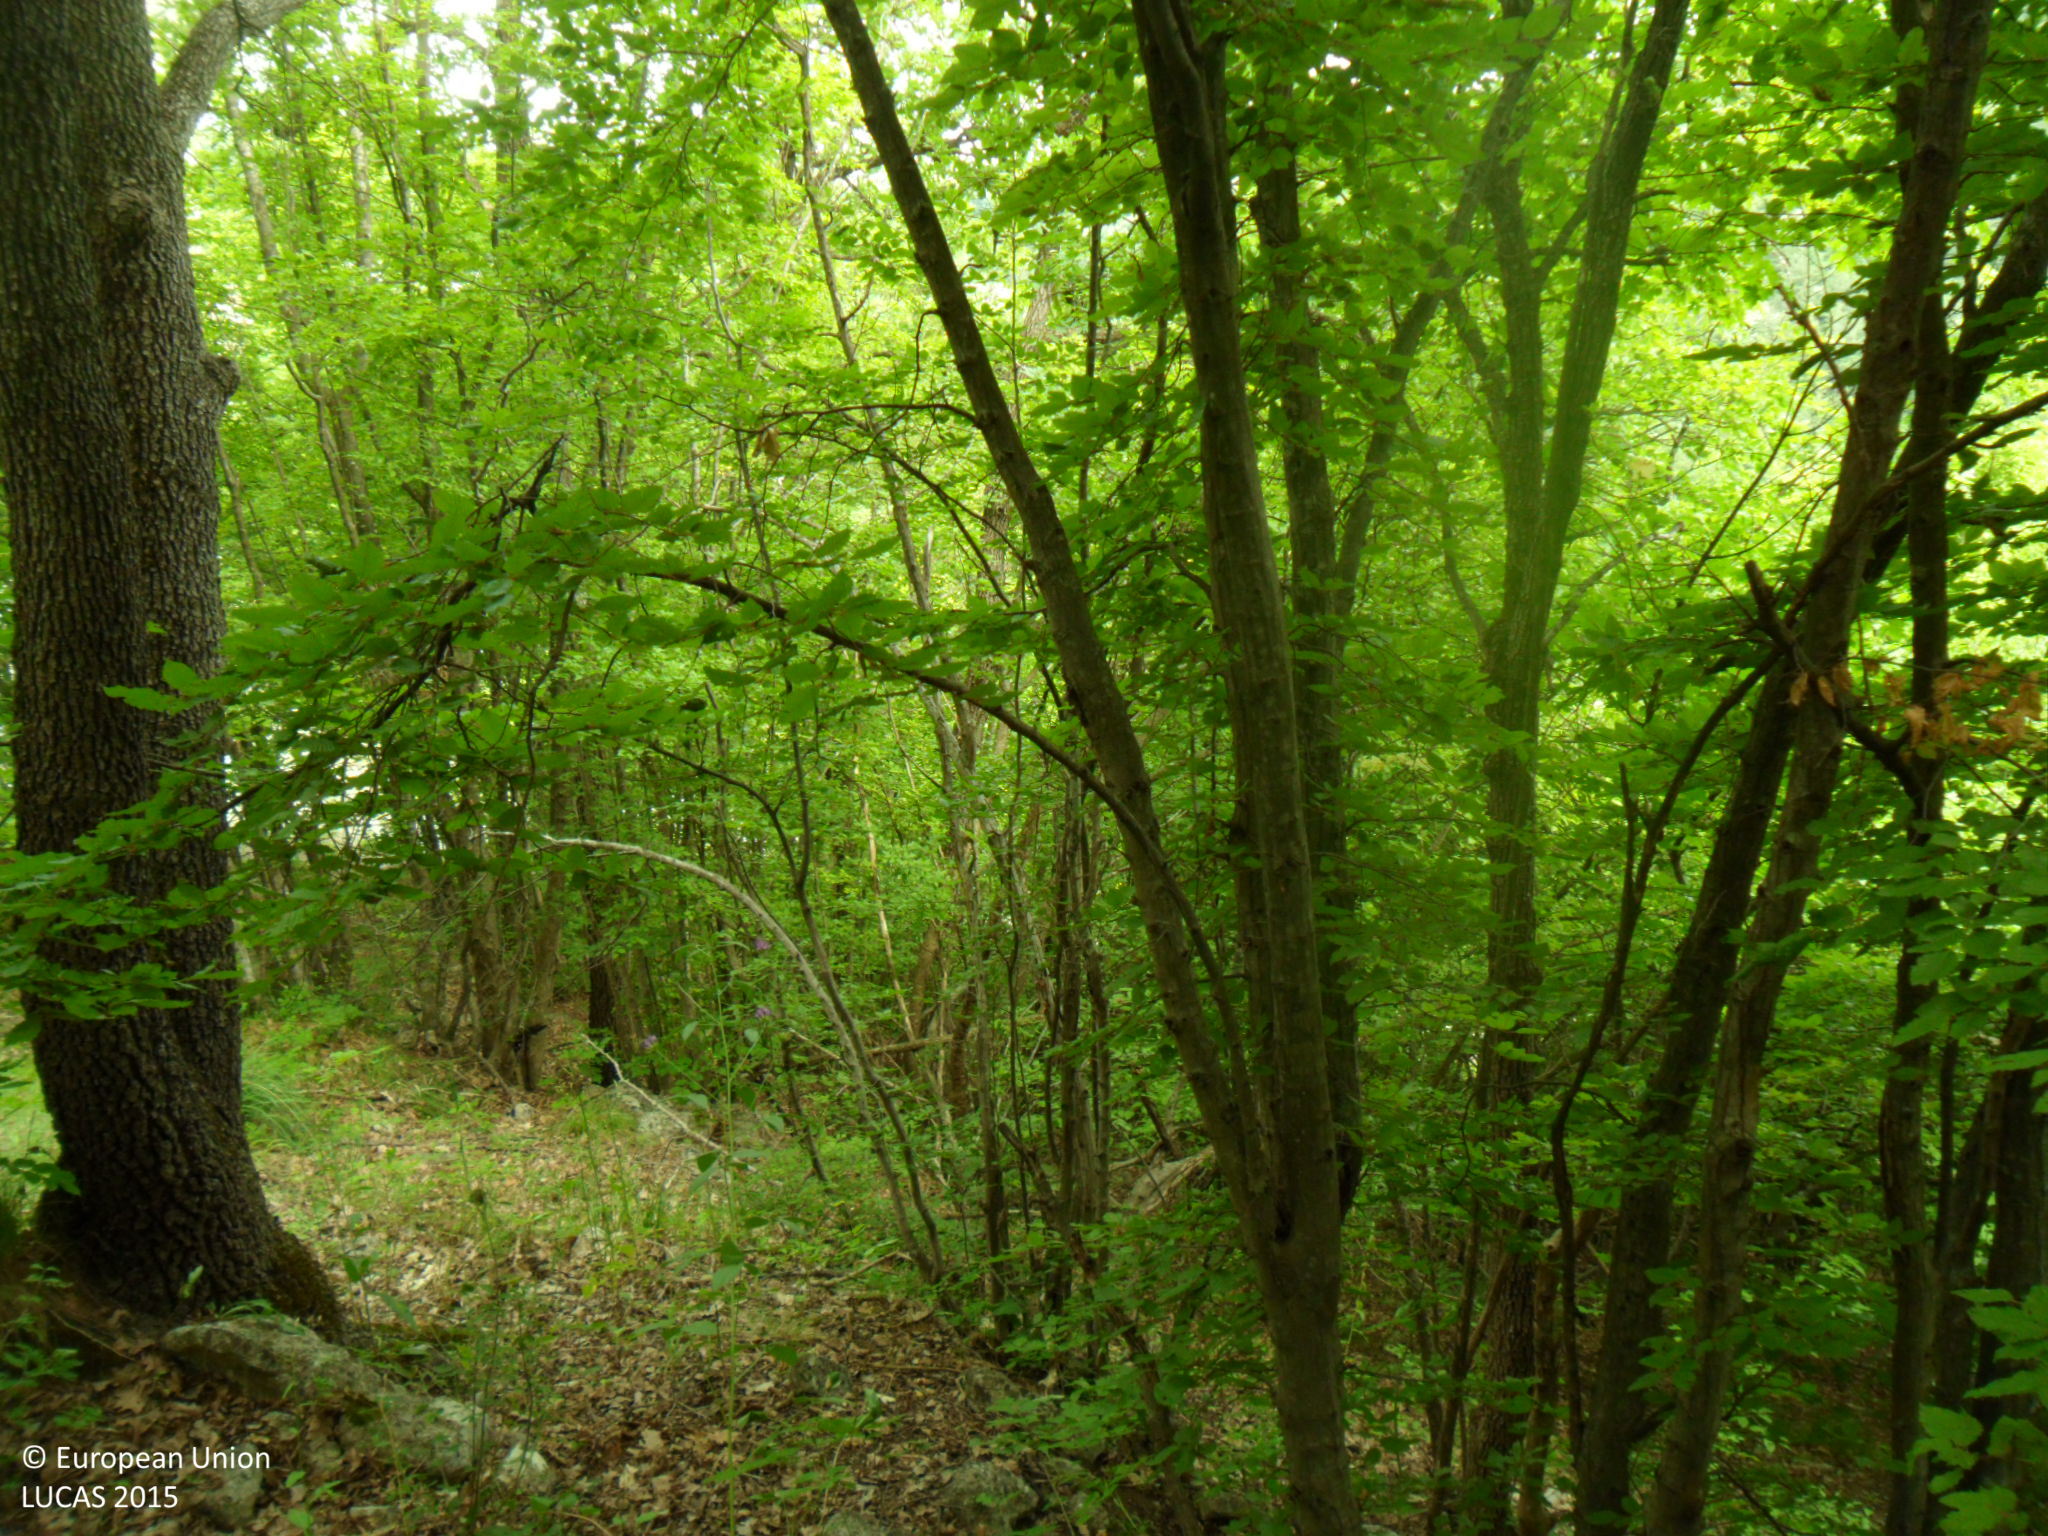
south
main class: Woodland
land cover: Broadleaved woodland
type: beech forest
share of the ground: > 75 %
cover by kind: broadleaved forest trees 100 %
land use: Forestry
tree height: > 5 m
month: June
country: BG
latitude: 43.3195
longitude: 26.7934
